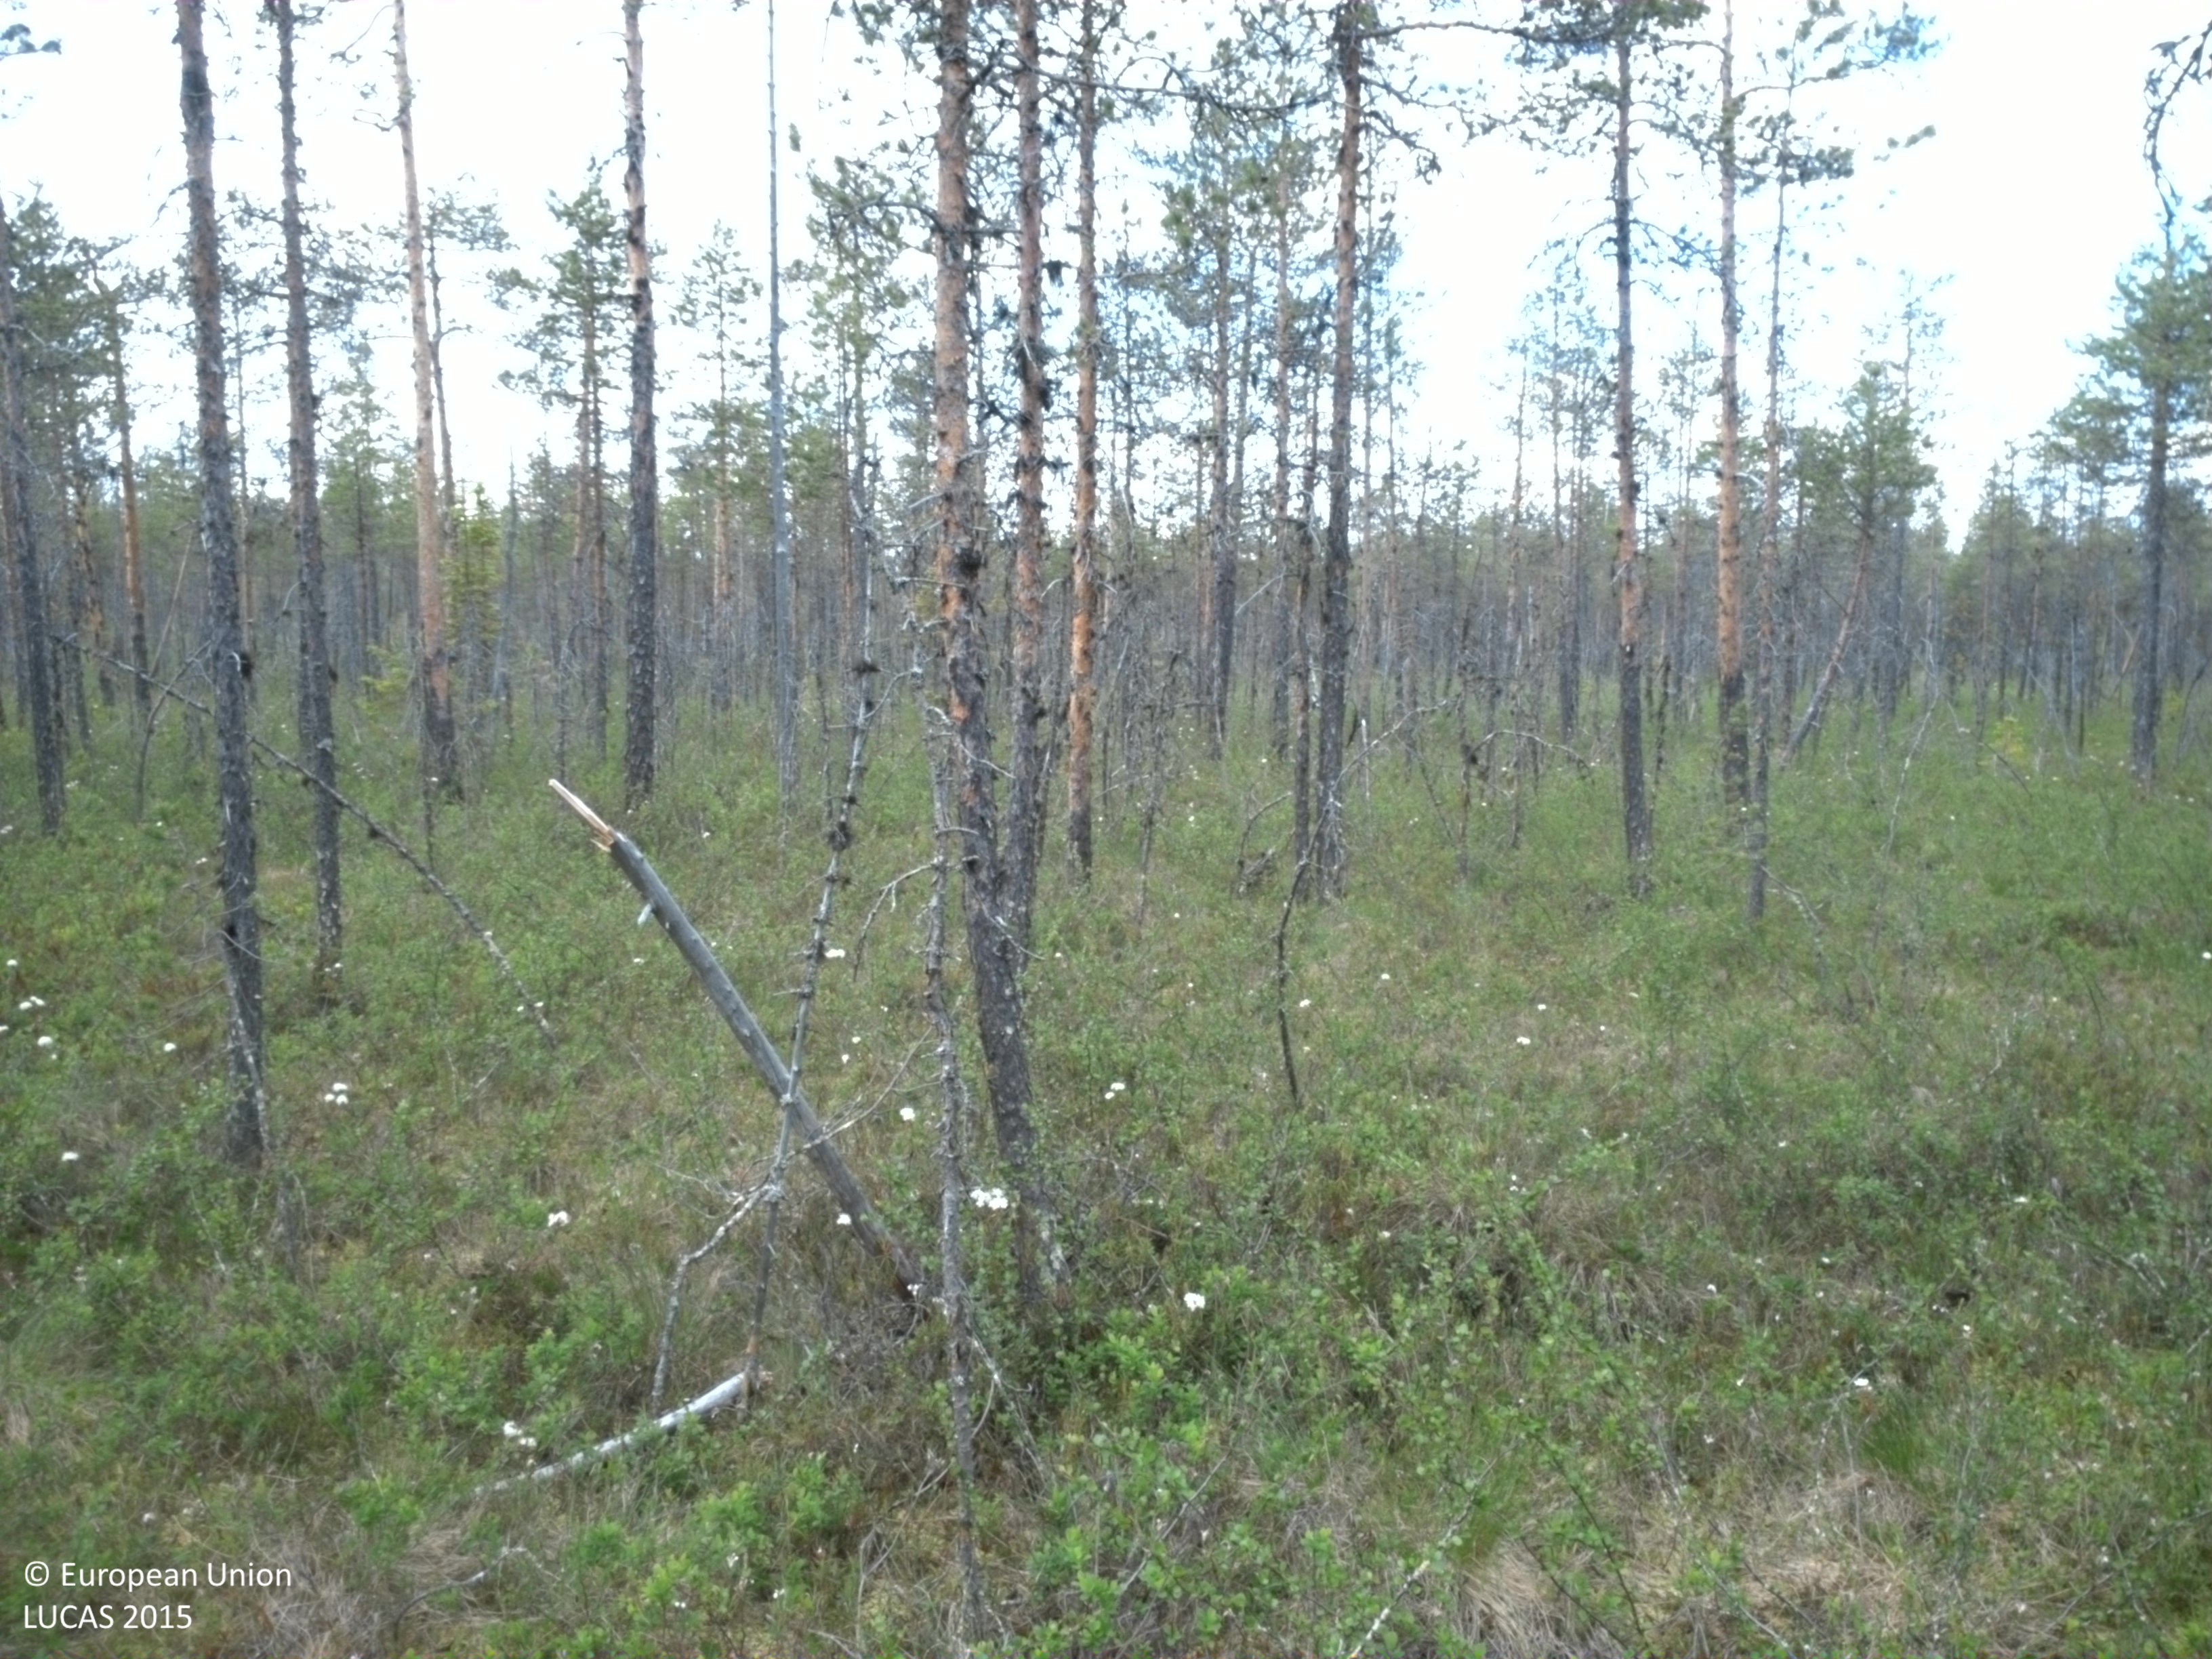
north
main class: Woodland
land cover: Pine dominated coniferous woodland
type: mire and swamp forests
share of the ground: 25 - 50 %
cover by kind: shrubs 65 %, coniferous forest trees 30 %, lichens and mosses 5 %
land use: Semi-natural and natural areas not in use
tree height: > 5 m
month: June
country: SE
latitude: 66.4377
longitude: 22.4589
